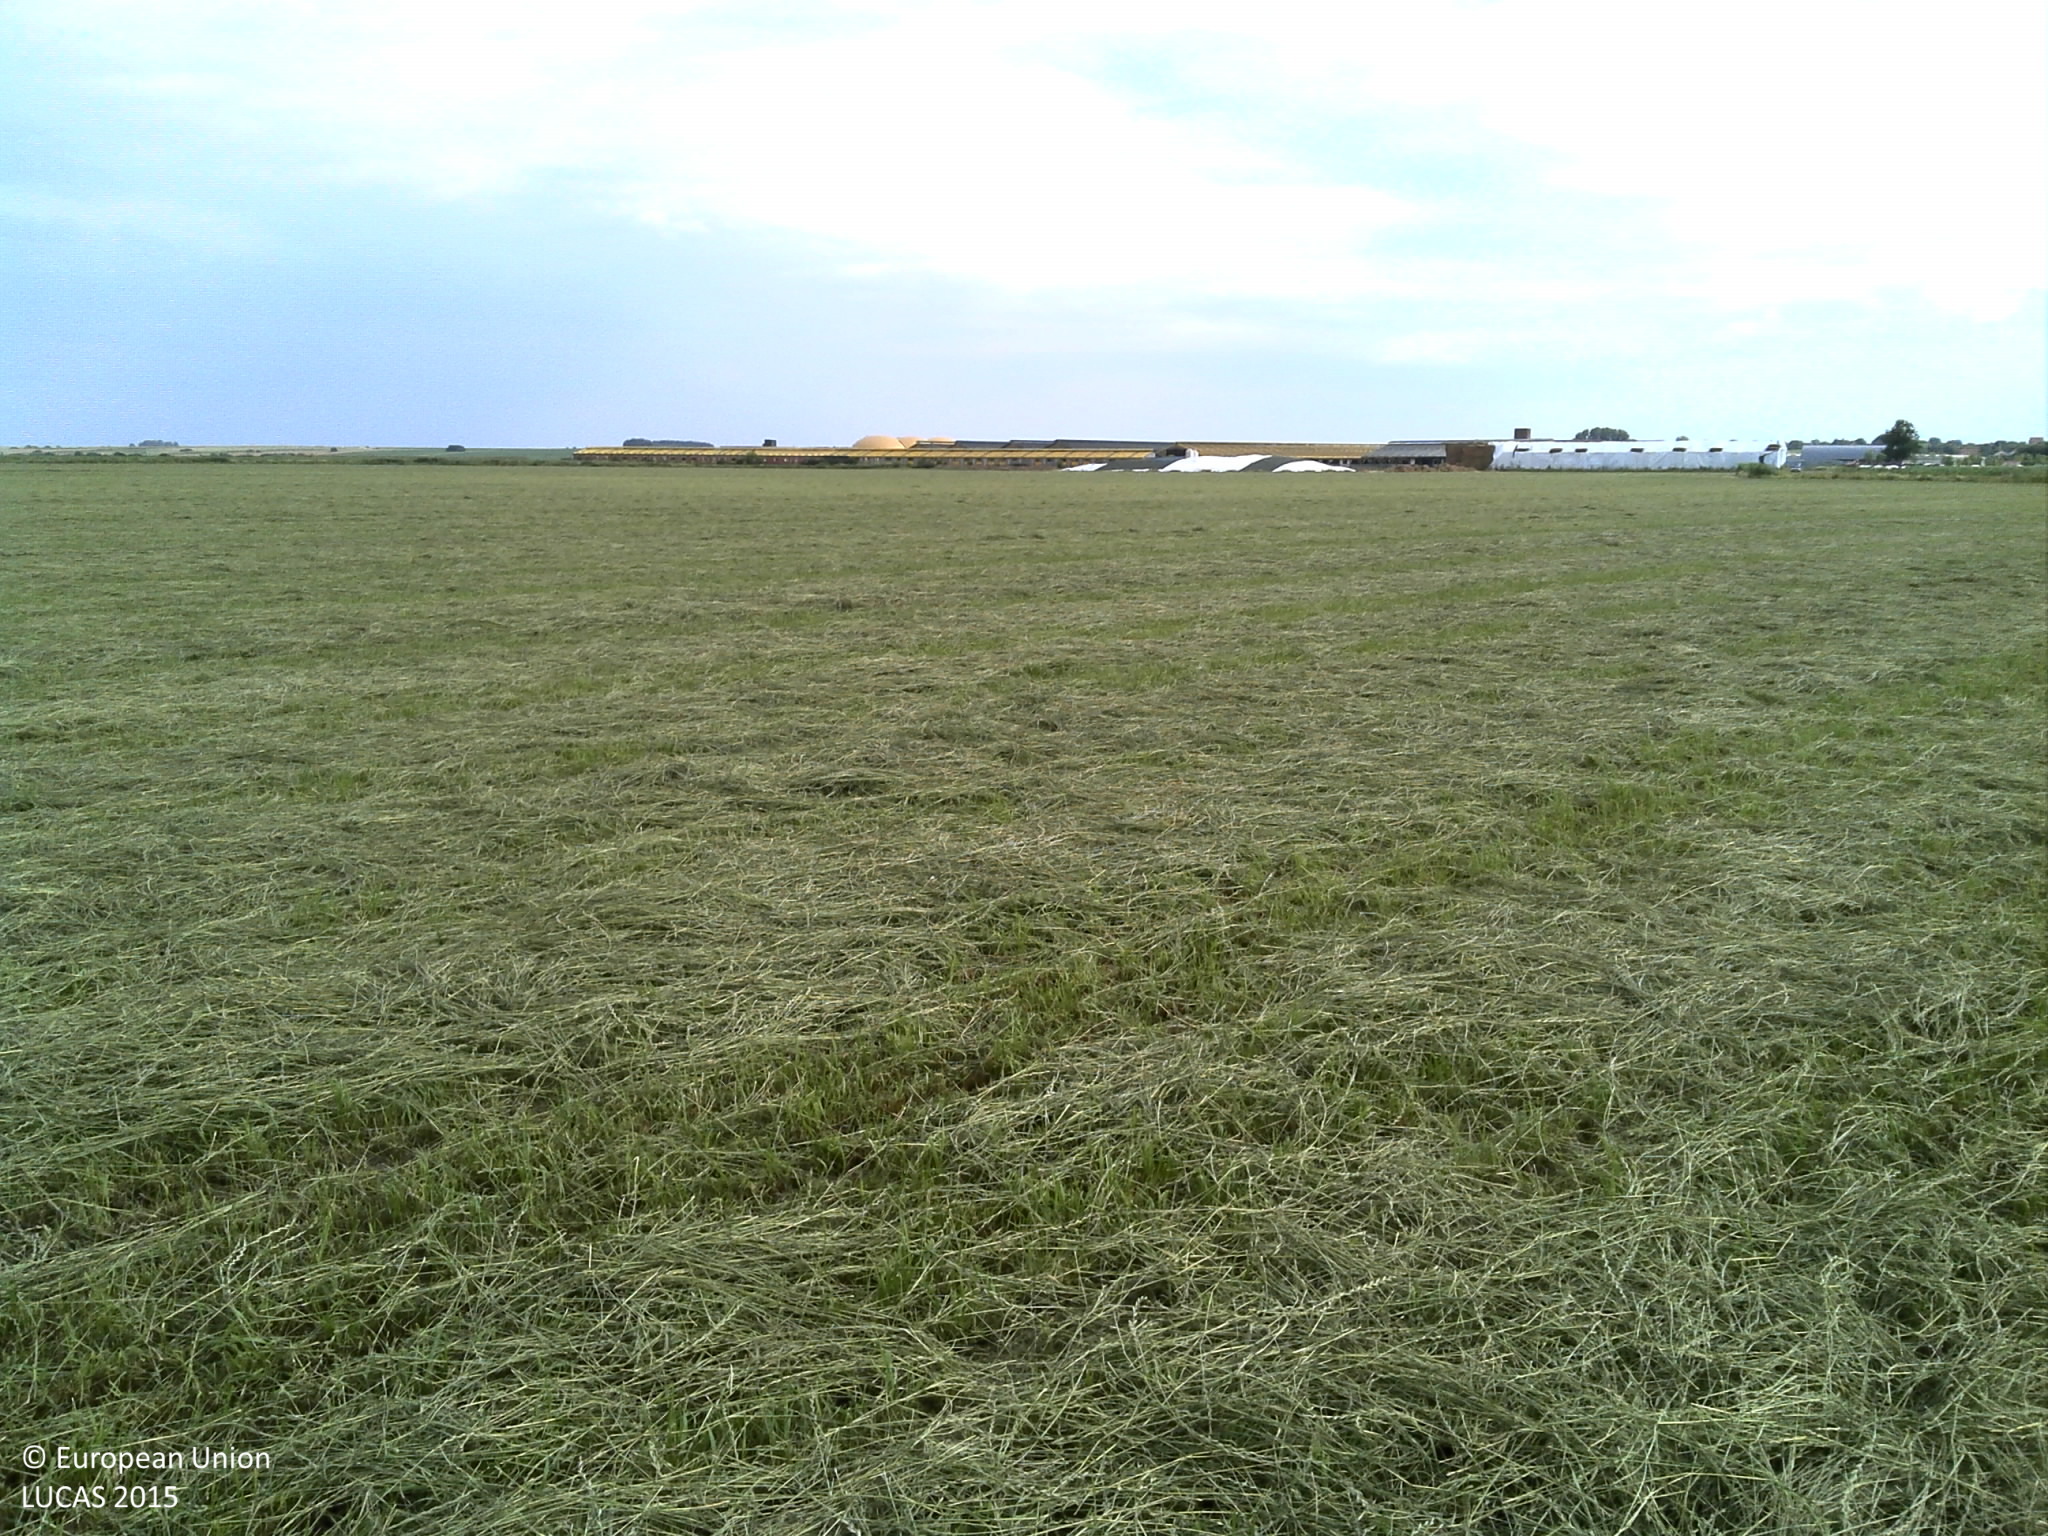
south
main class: Grassland
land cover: Grassland without tree/shrub cover
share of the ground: > 75 %
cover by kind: herbaceous plants 100 %
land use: Agriculture (excluding fallow land and kitchen gardens)
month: June
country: HR
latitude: 45.4027
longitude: 18.4247
